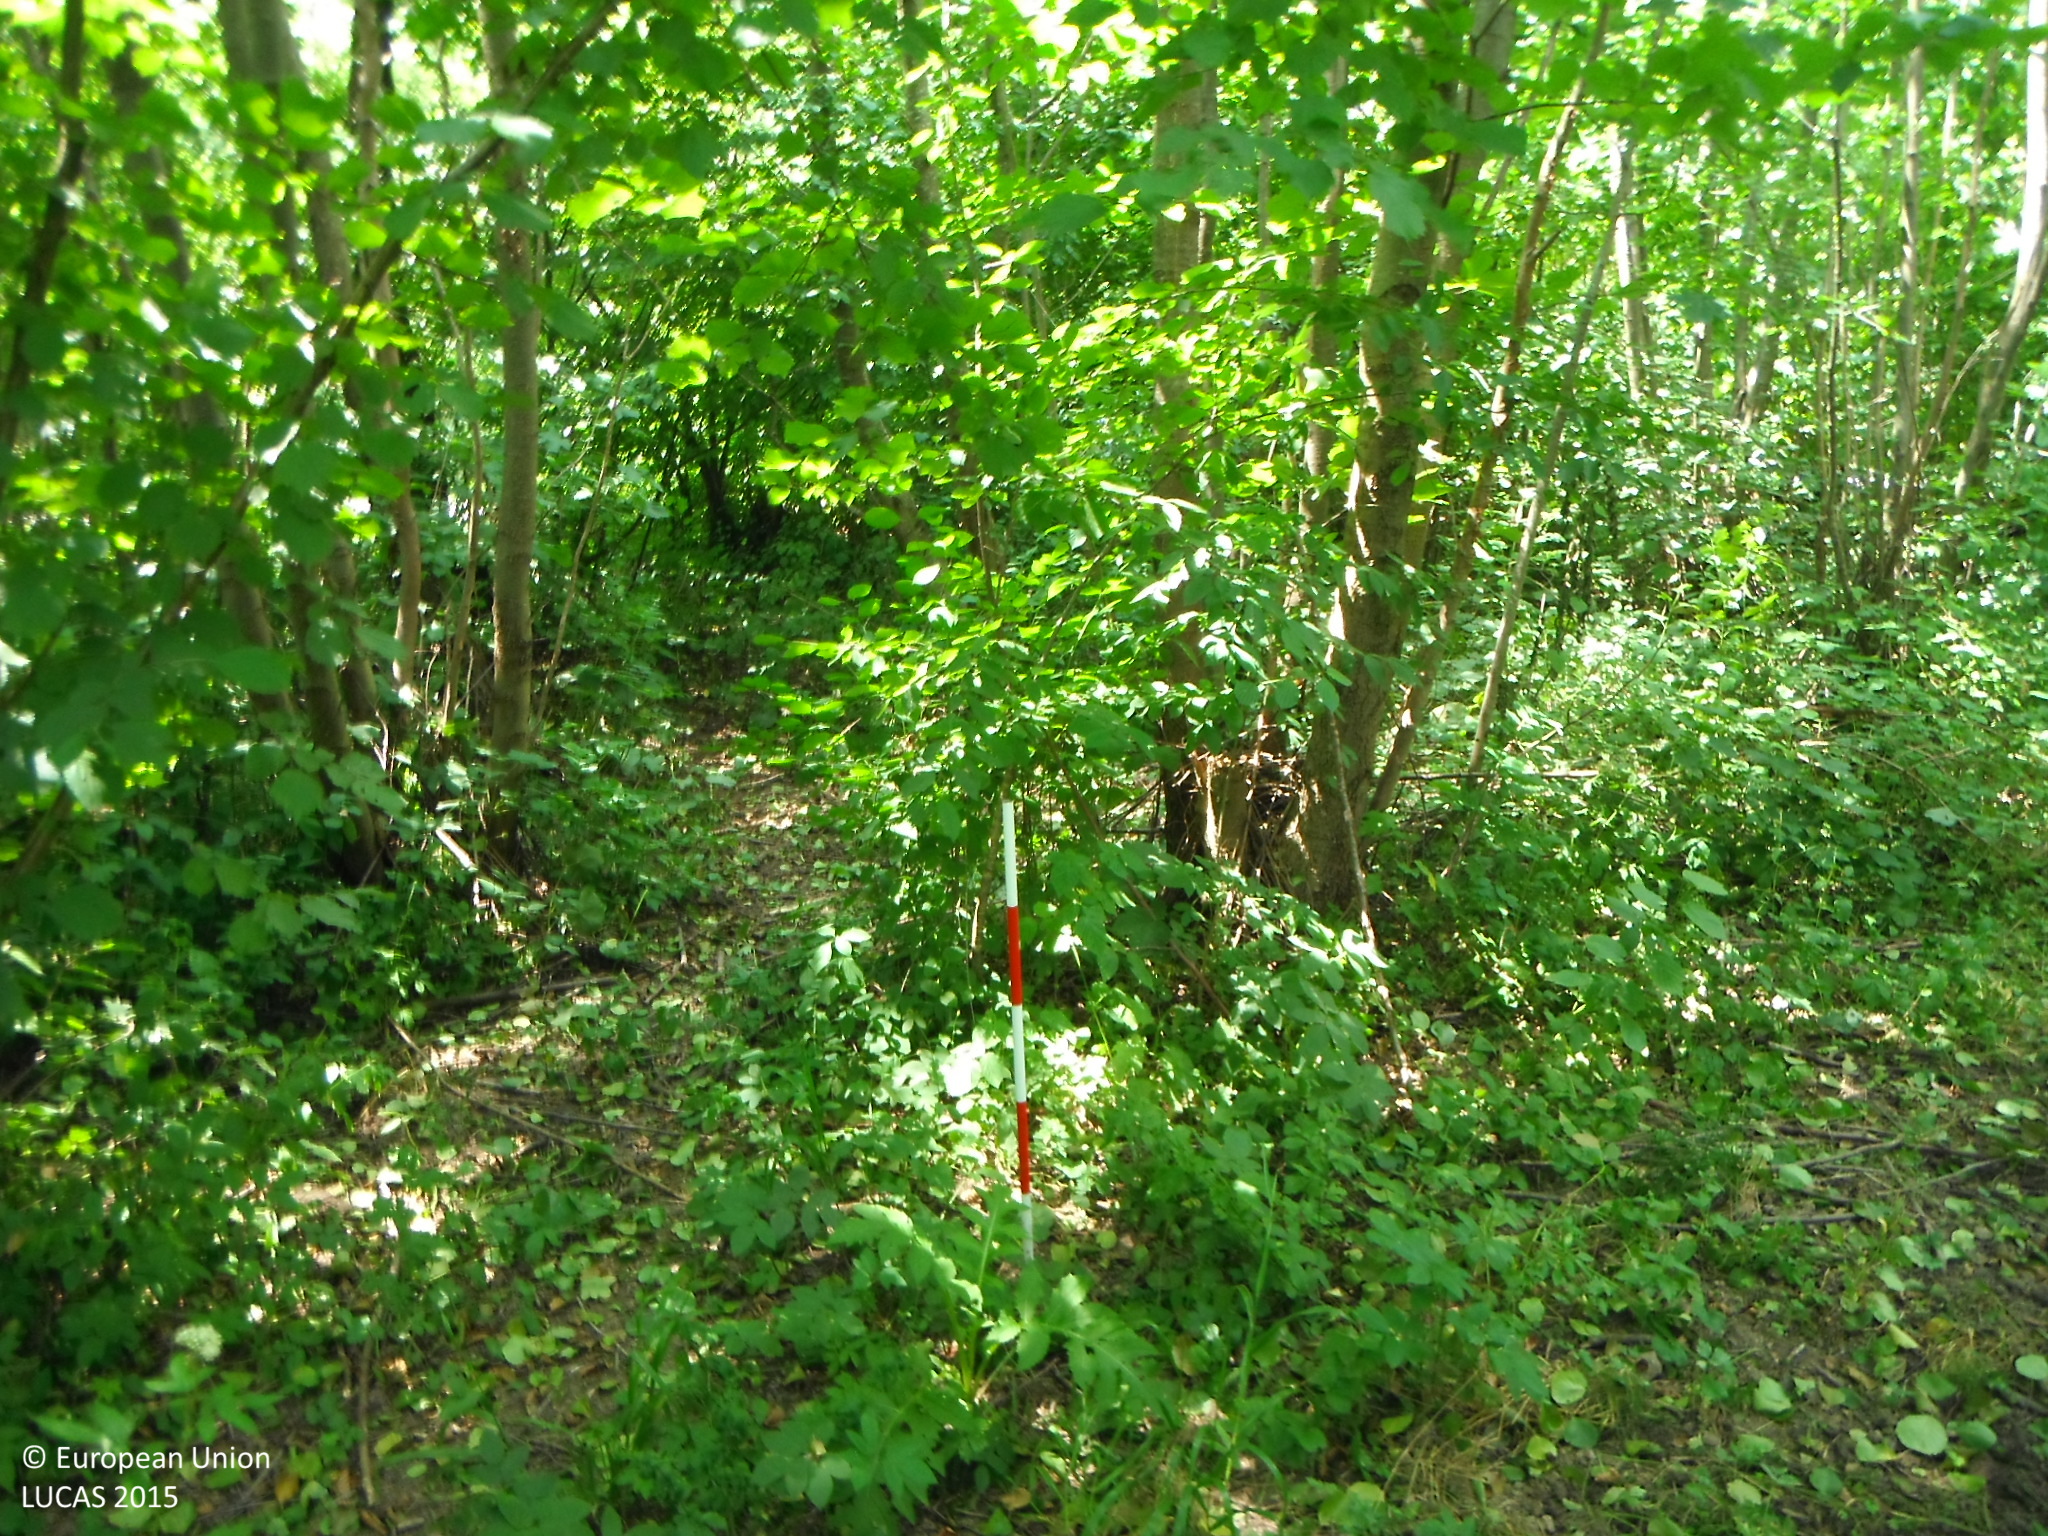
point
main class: Woodland
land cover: Broadleaved woodland
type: mesophytic deciduous forest
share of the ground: > 75 %
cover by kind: broadleaved forest trees 100 %
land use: Semi-natural and natural areas not in use
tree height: > 5 m
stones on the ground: < 10 %
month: July
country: SK
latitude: 48.7167
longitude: 20.1301
